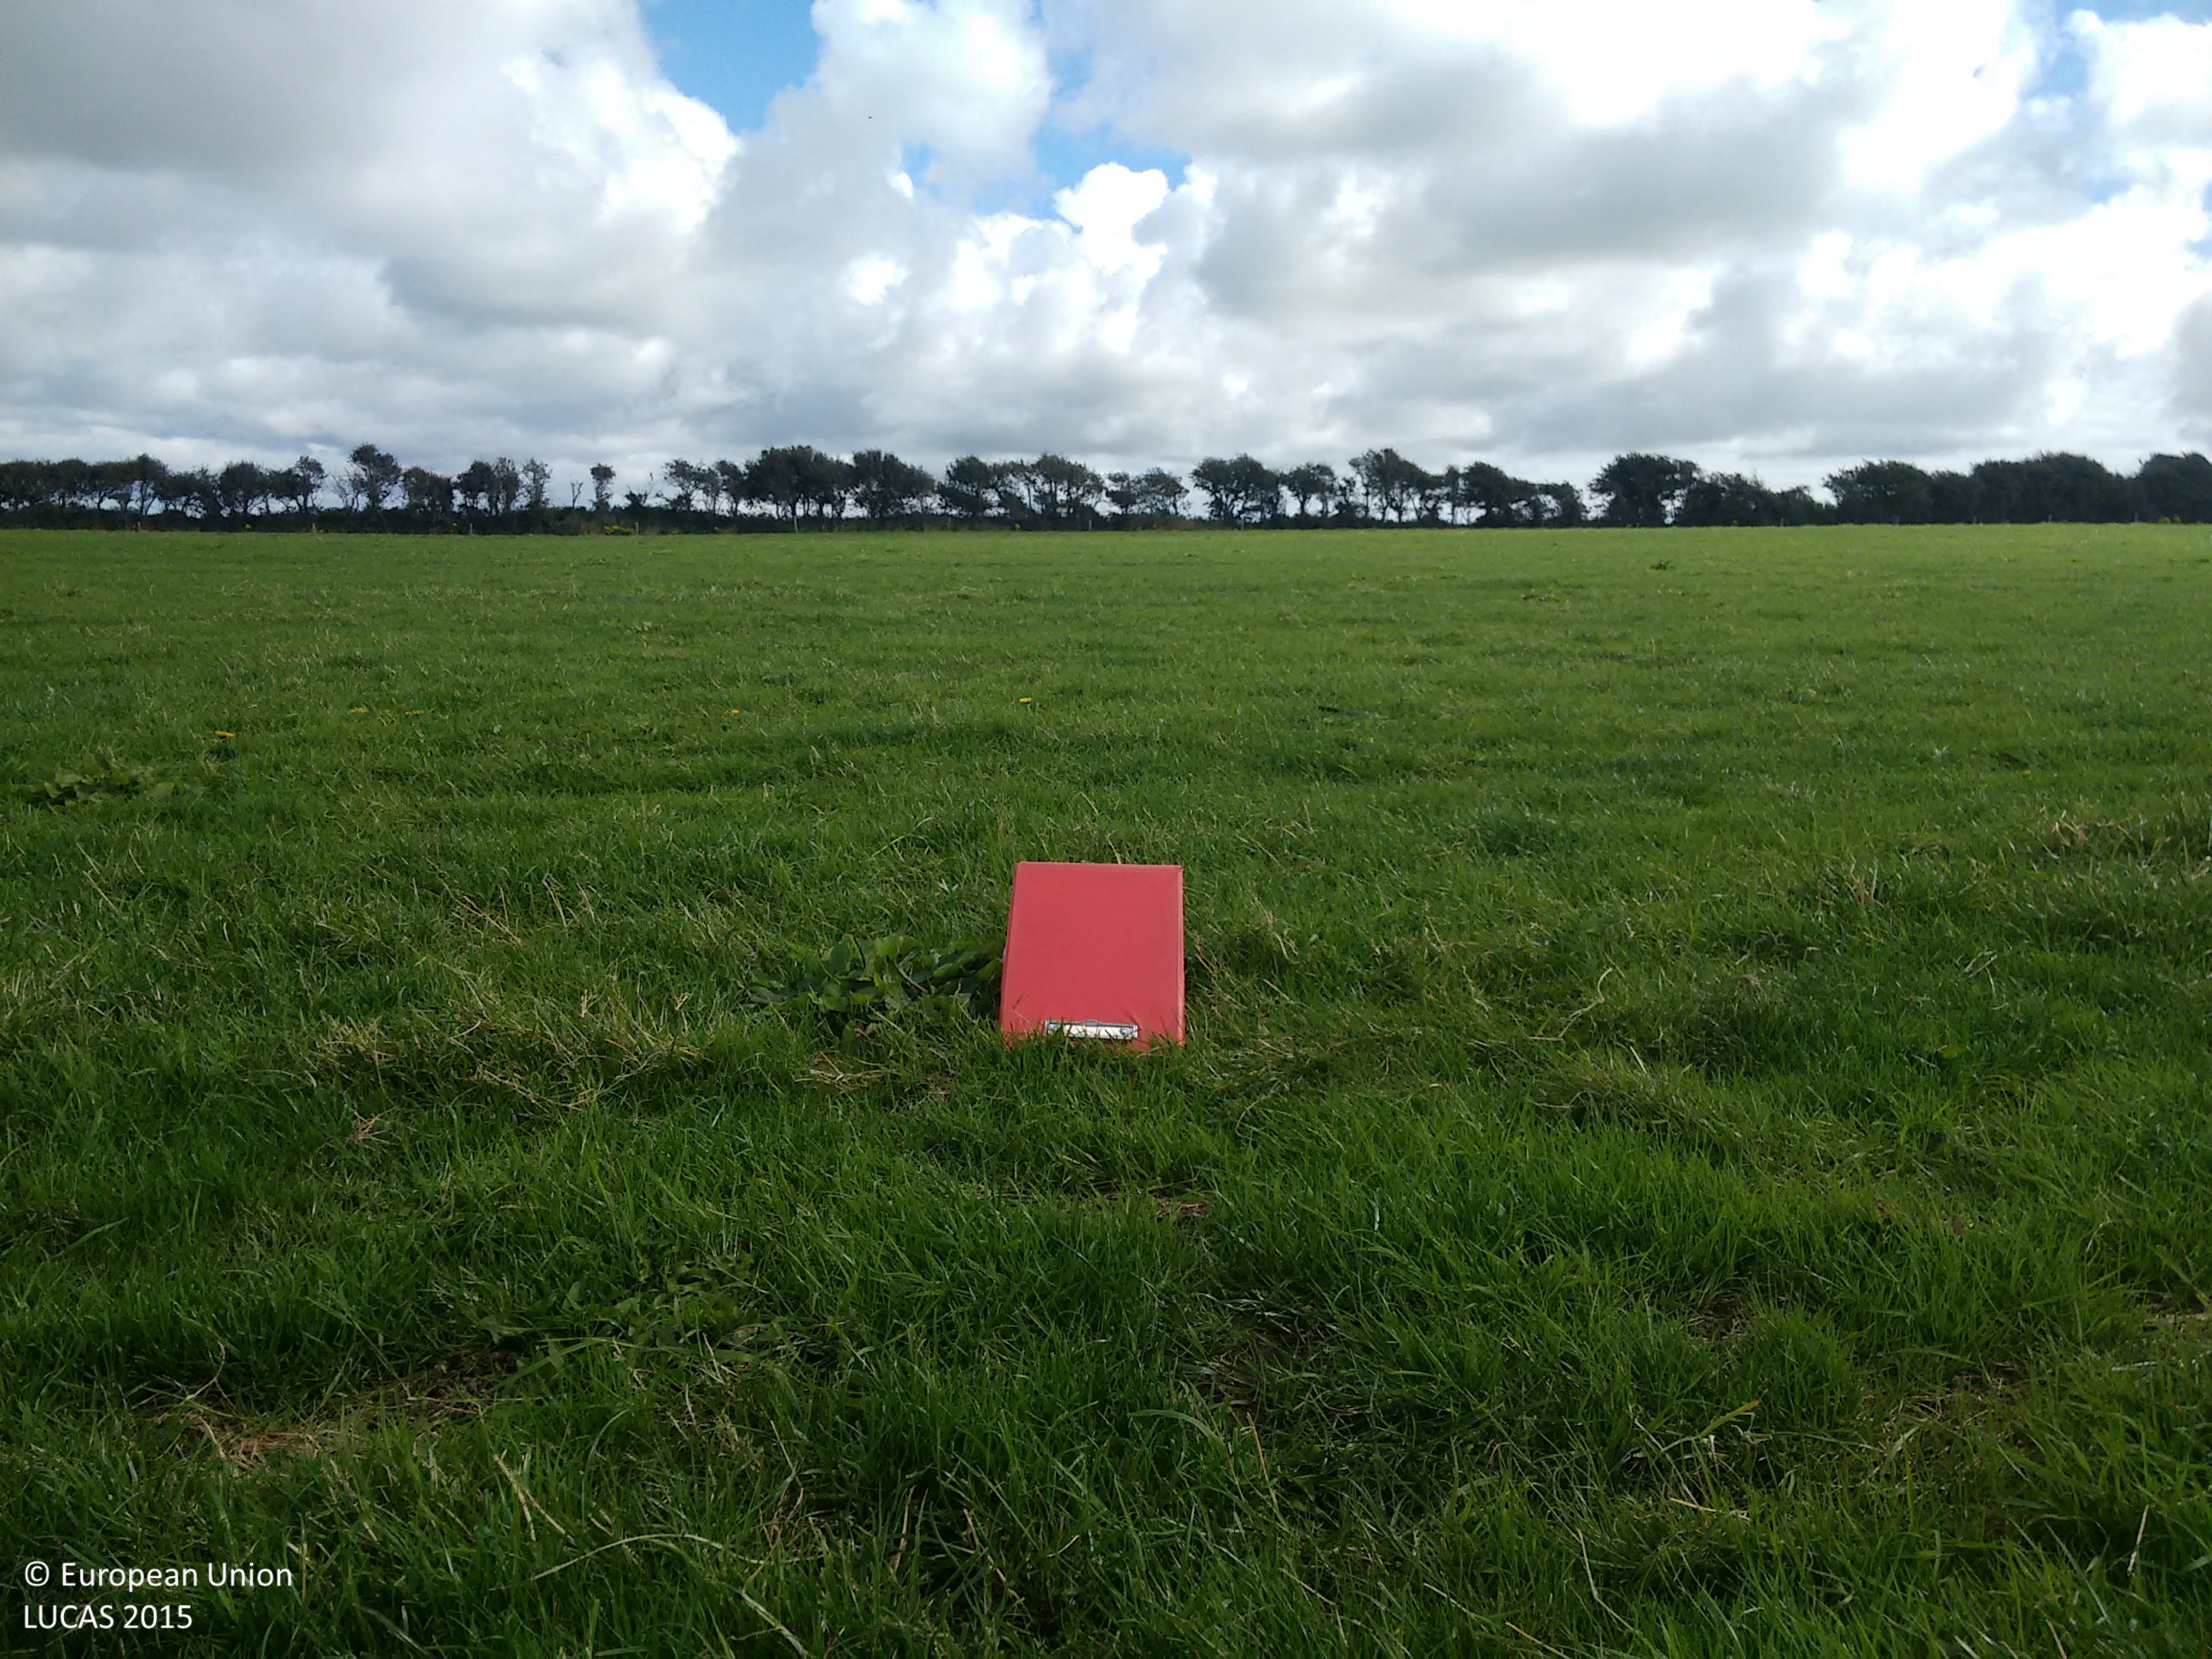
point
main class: Grassland
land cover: Grassland without tree/shrub cover
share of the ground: > 75 %
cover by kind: herbaceous plants 90 %, shrubs 5 %, unconsolidated bare surface 5 %
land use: Agriculture (excluding fallow land and kitchen gardens)
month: September
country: IE
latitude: 52.3606
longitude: -9.7593
